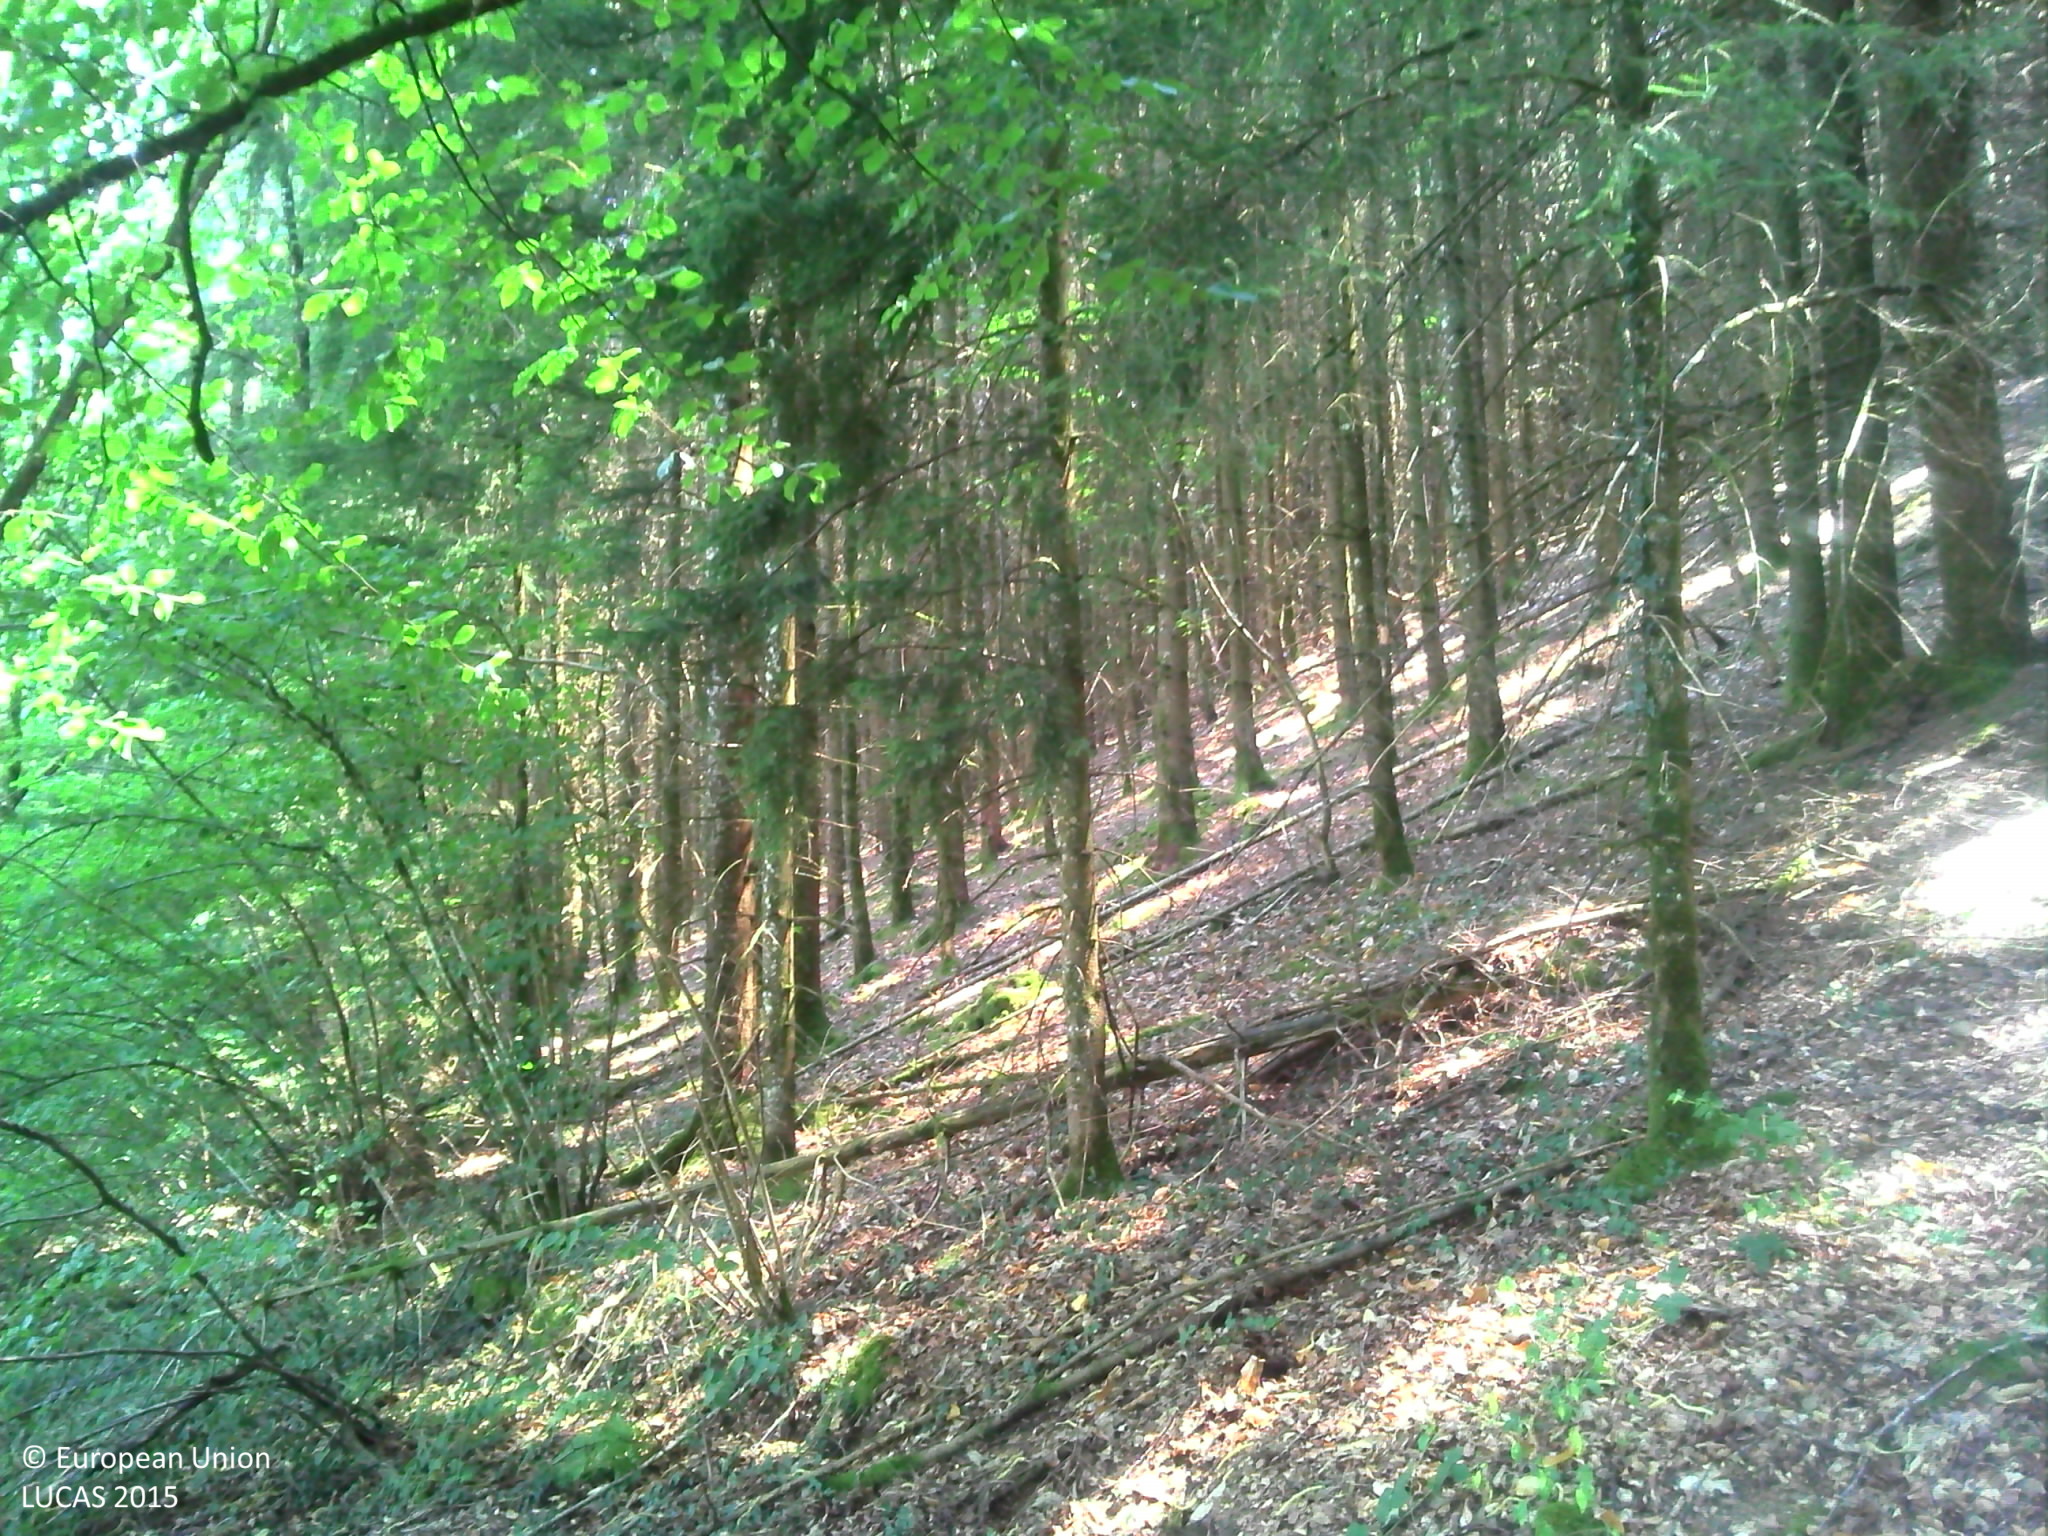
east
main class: Woodland
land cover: Spruce dominated mixed woodland
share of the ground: > 75 %
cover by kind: coniferous forest trees 45 %, broadleaved forest trees 40 %, shrubs 5 %, herbaceous plants 5 %, lichens and mosses 5 %
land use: Forestry
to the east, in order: Spruce dominated mixed woodland; Spruce dominated coniferous woodland; Tracks; Spruce dominated coniferous woodland
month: July
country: FR
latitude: 45.9457
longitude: 1.8021
